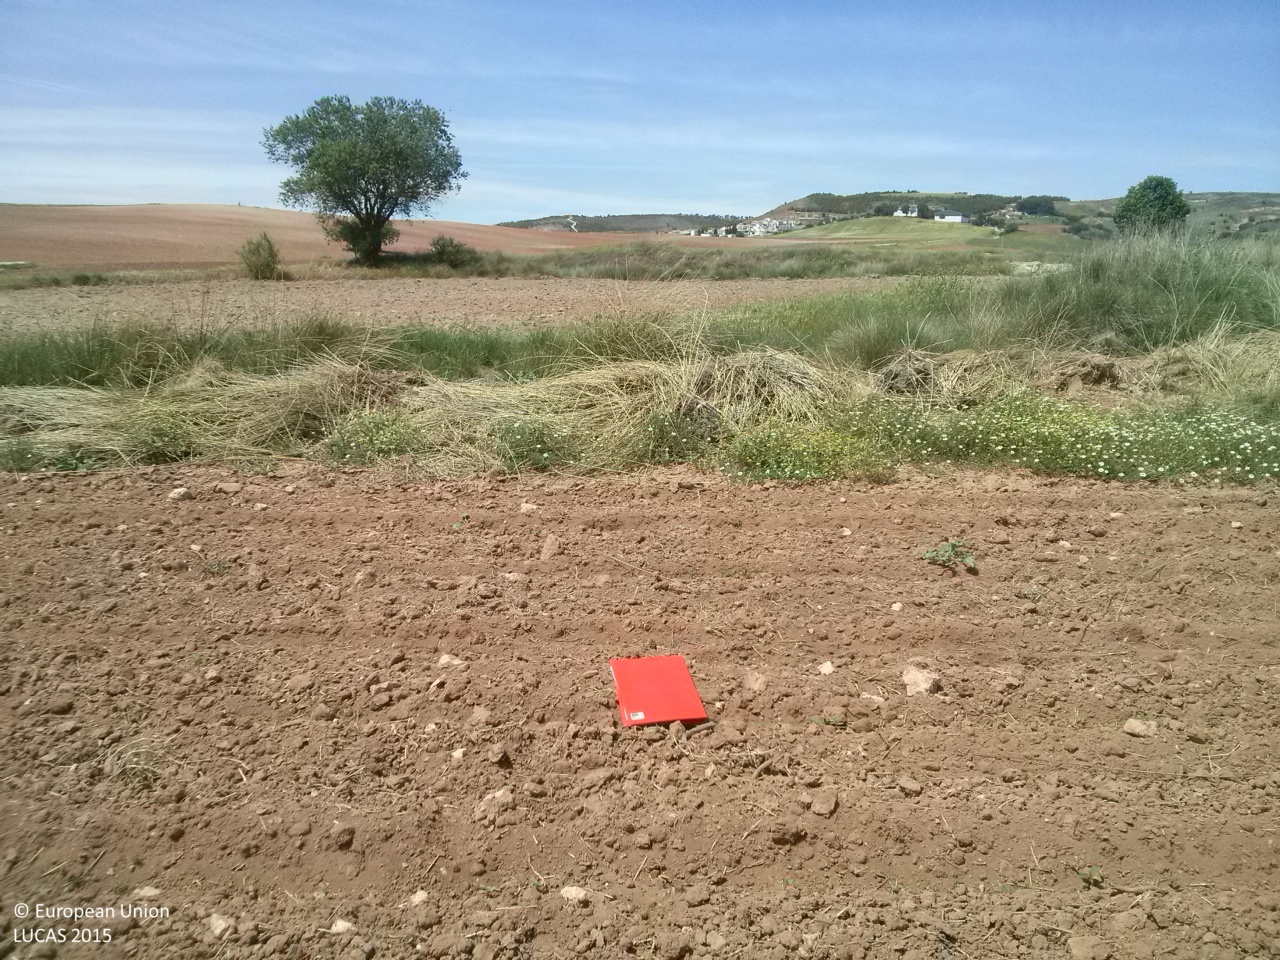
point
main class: Cropland
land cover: Sunflower
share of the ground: < 10 %
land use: Agriculture (excluding fallow land and kitchen gardens)
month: May
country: ES
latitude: 40.0432
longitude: -2.6908
